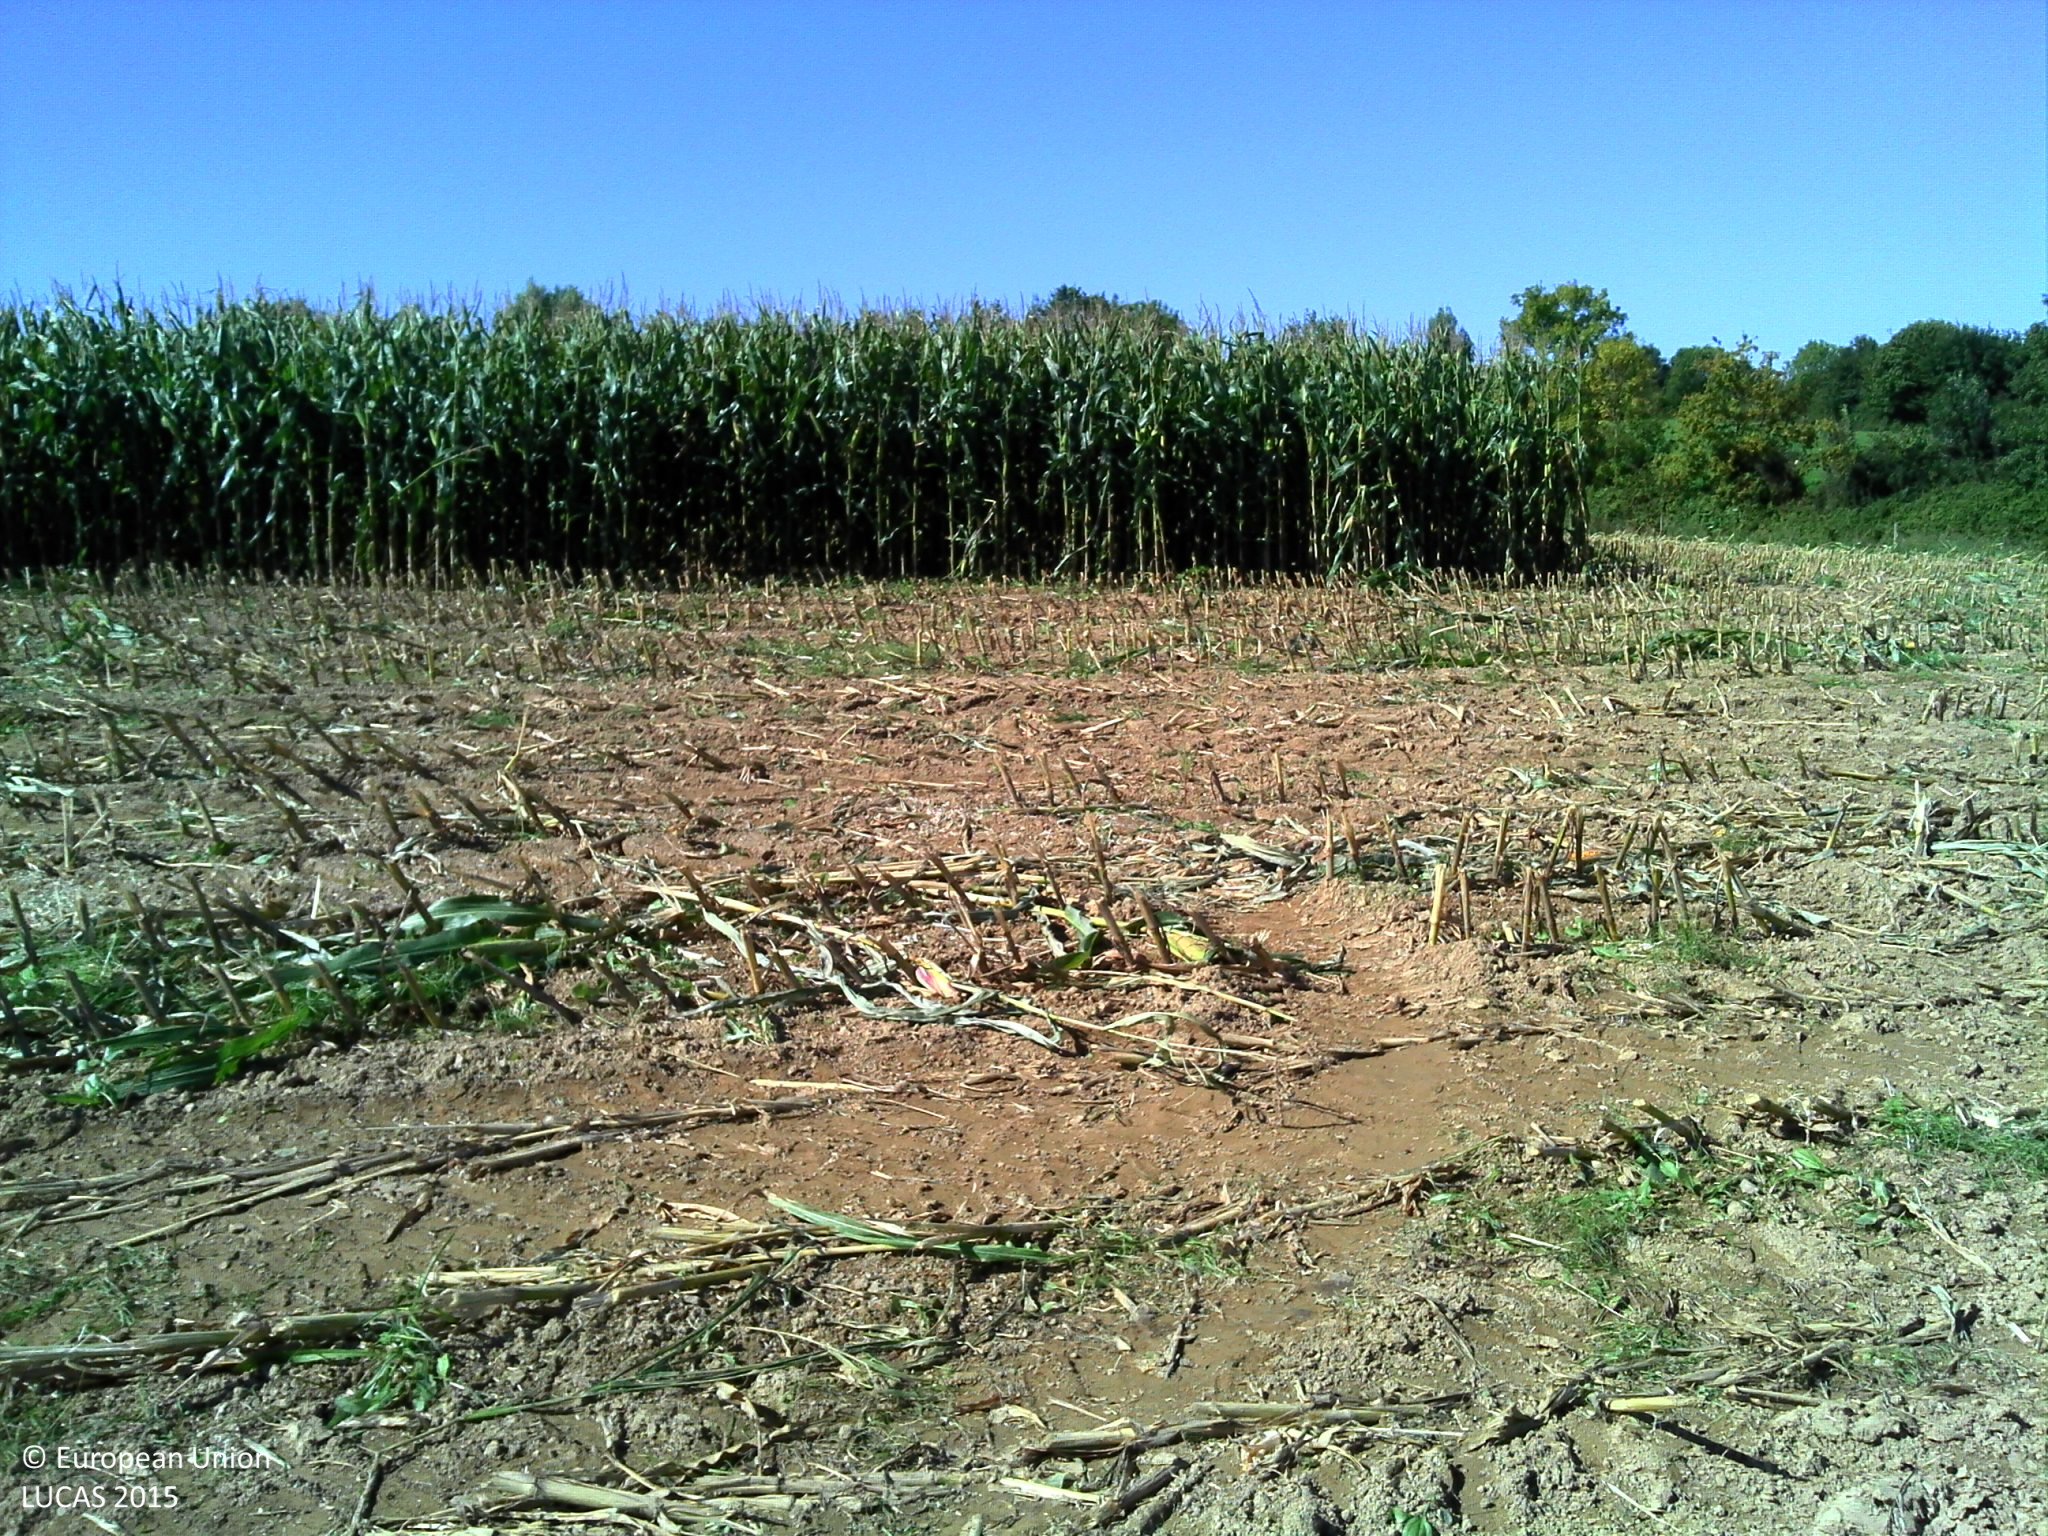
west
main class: Grassland
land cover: Grassland without tree/shrub cover
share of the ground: > 75 %
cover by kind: herbaceous plants 100 %
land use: Agriculture (excluding fallow land and kitchen gardens)
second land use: Amenities, museums, leisure
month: September
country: FR
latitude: 46.5689
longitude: -1.2950
